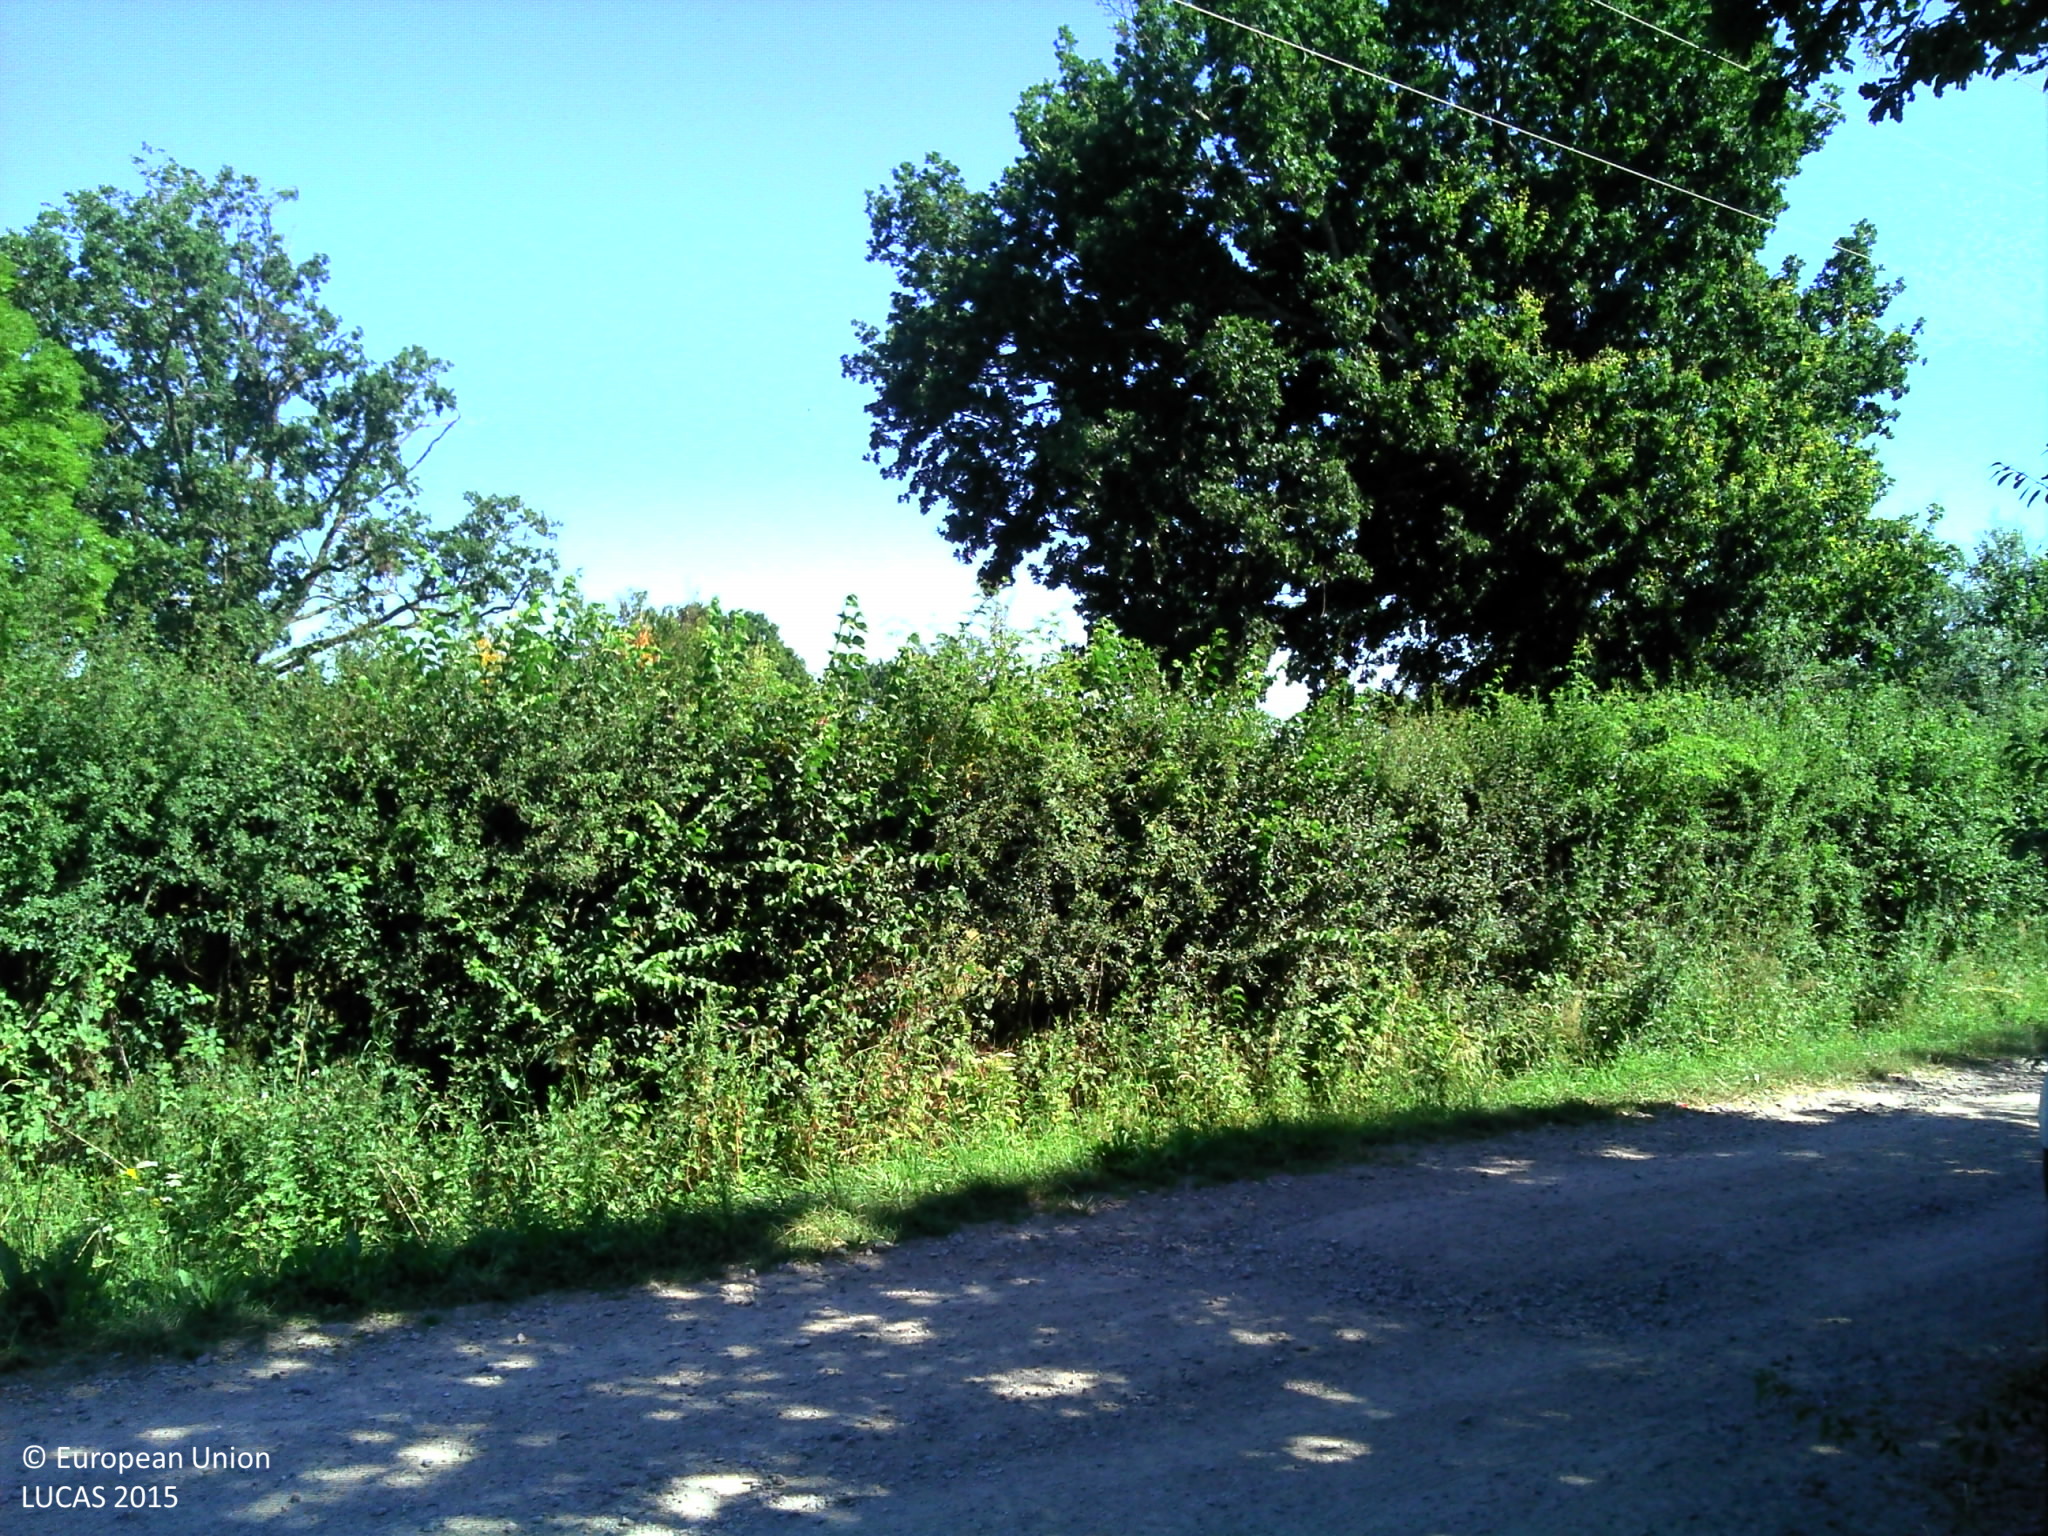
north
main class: Grassland
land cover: Grassland without tree/shrub cover
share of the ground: > 75 %
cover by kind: herbaceous plants 100 %
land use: Agriculture (excluding fallow land and kitchen gardens)
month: June
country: FR
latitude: 46.1936
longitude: 3.2740
